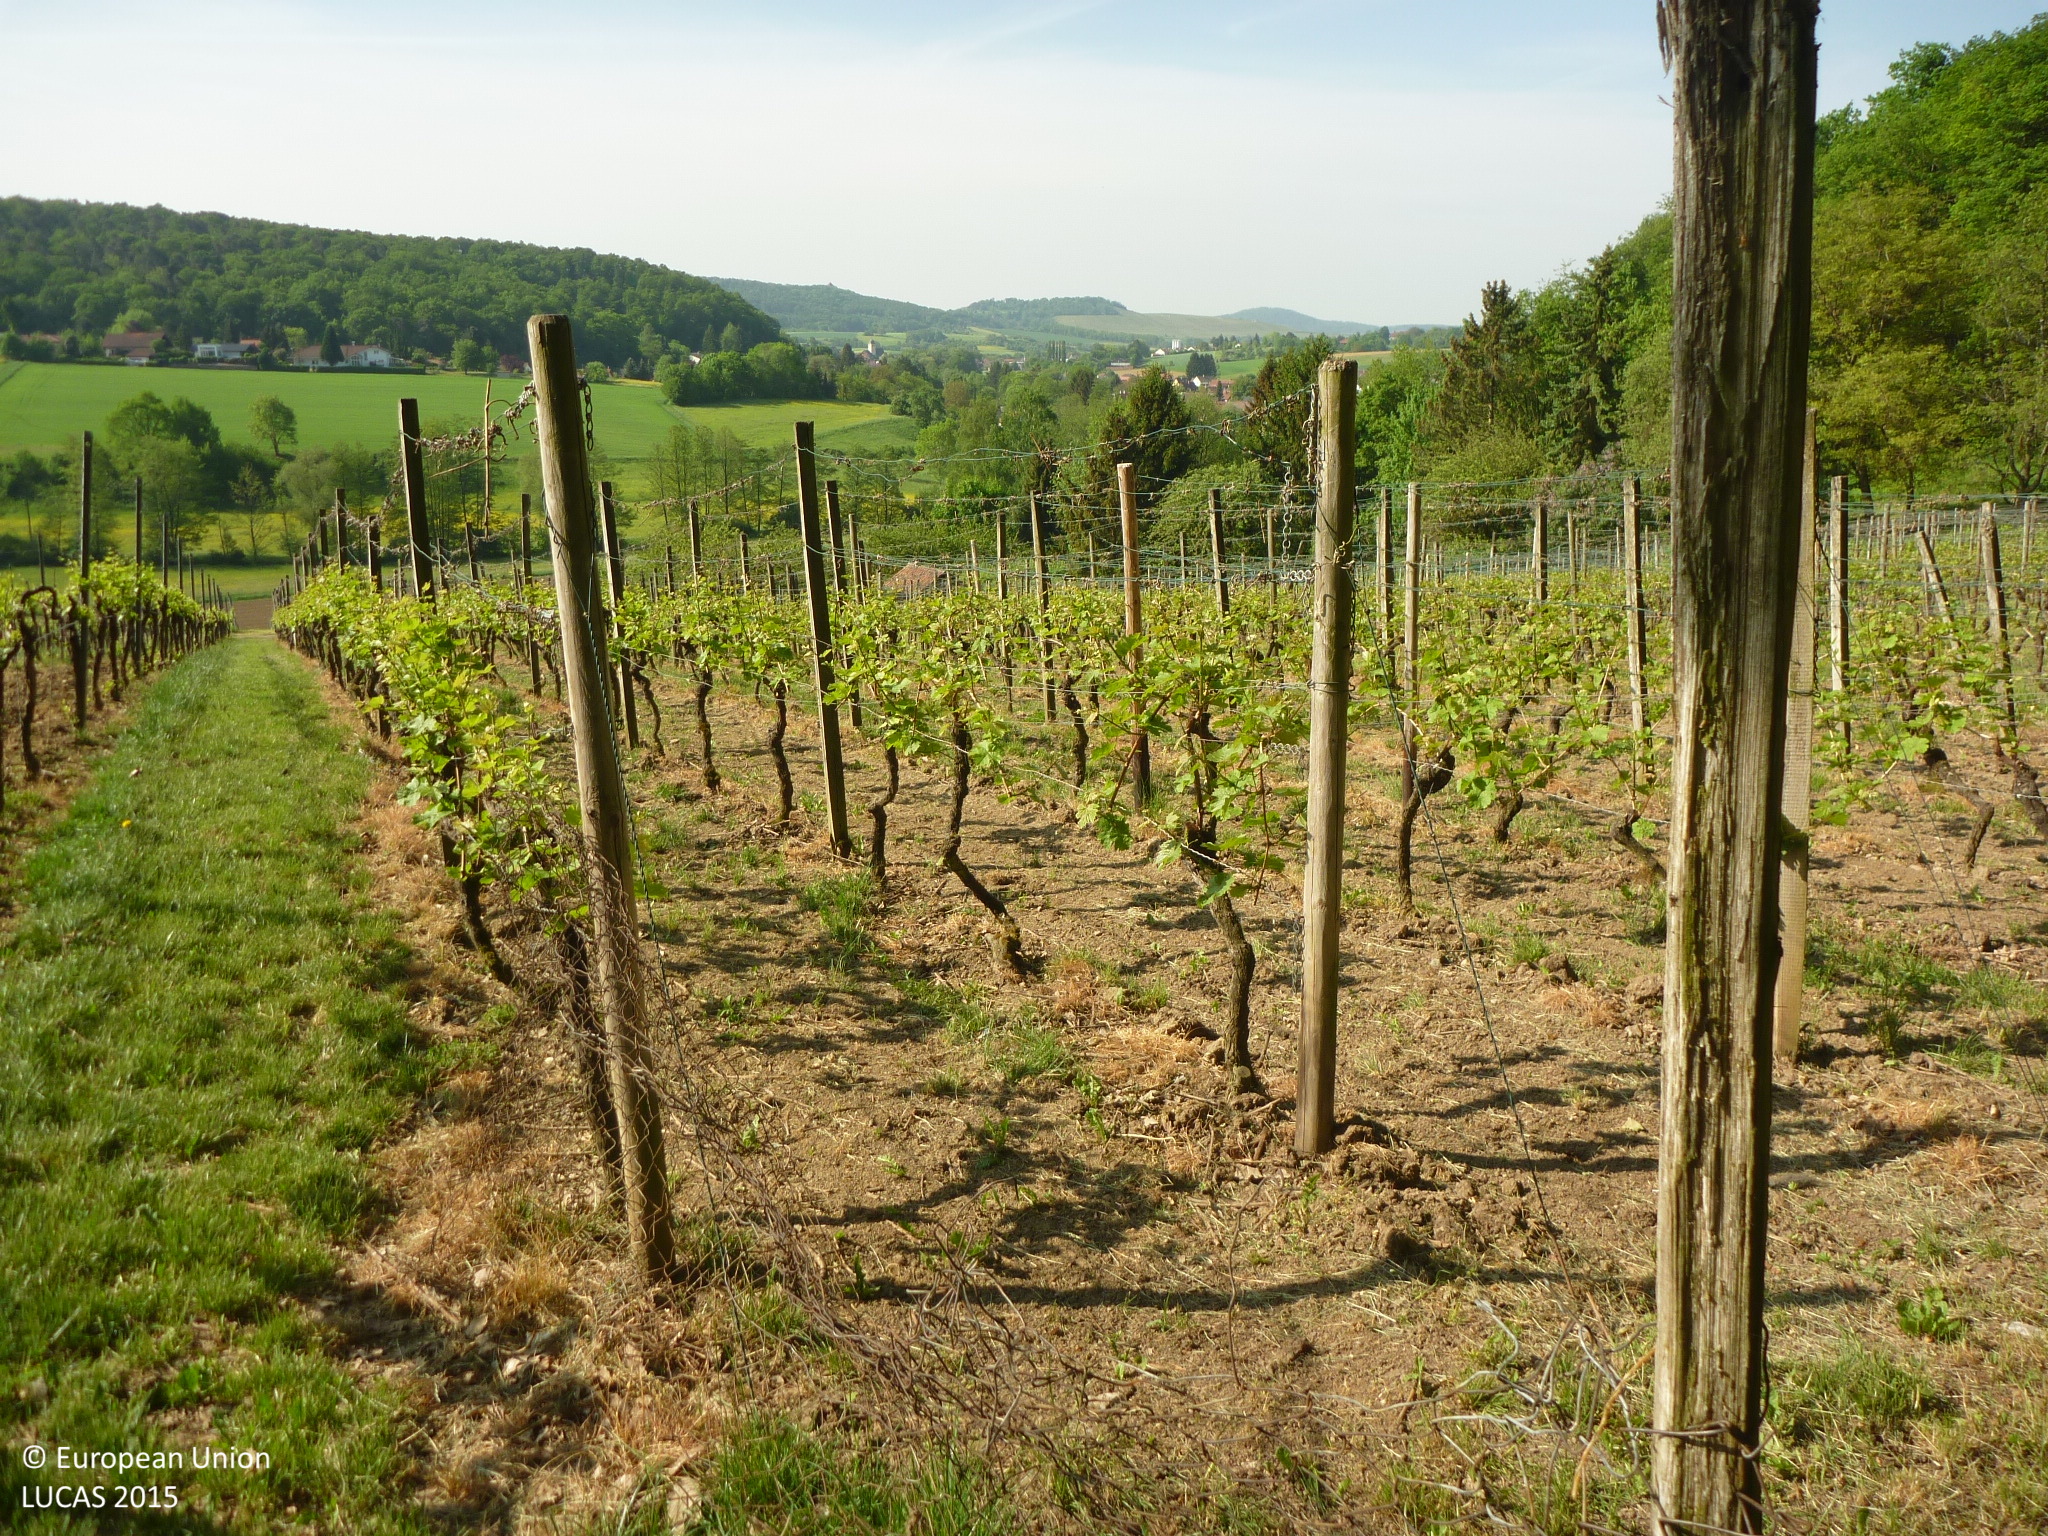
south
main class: Cropland
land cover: Vineyards
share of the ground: 25 - 50 %
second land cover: Grassland without tree/shrub cover
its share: > 75 %
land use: Agriculture (excluding fallow land and kitchen gardens)
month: May
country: DE
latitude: 49.1031
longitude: 9.3291
